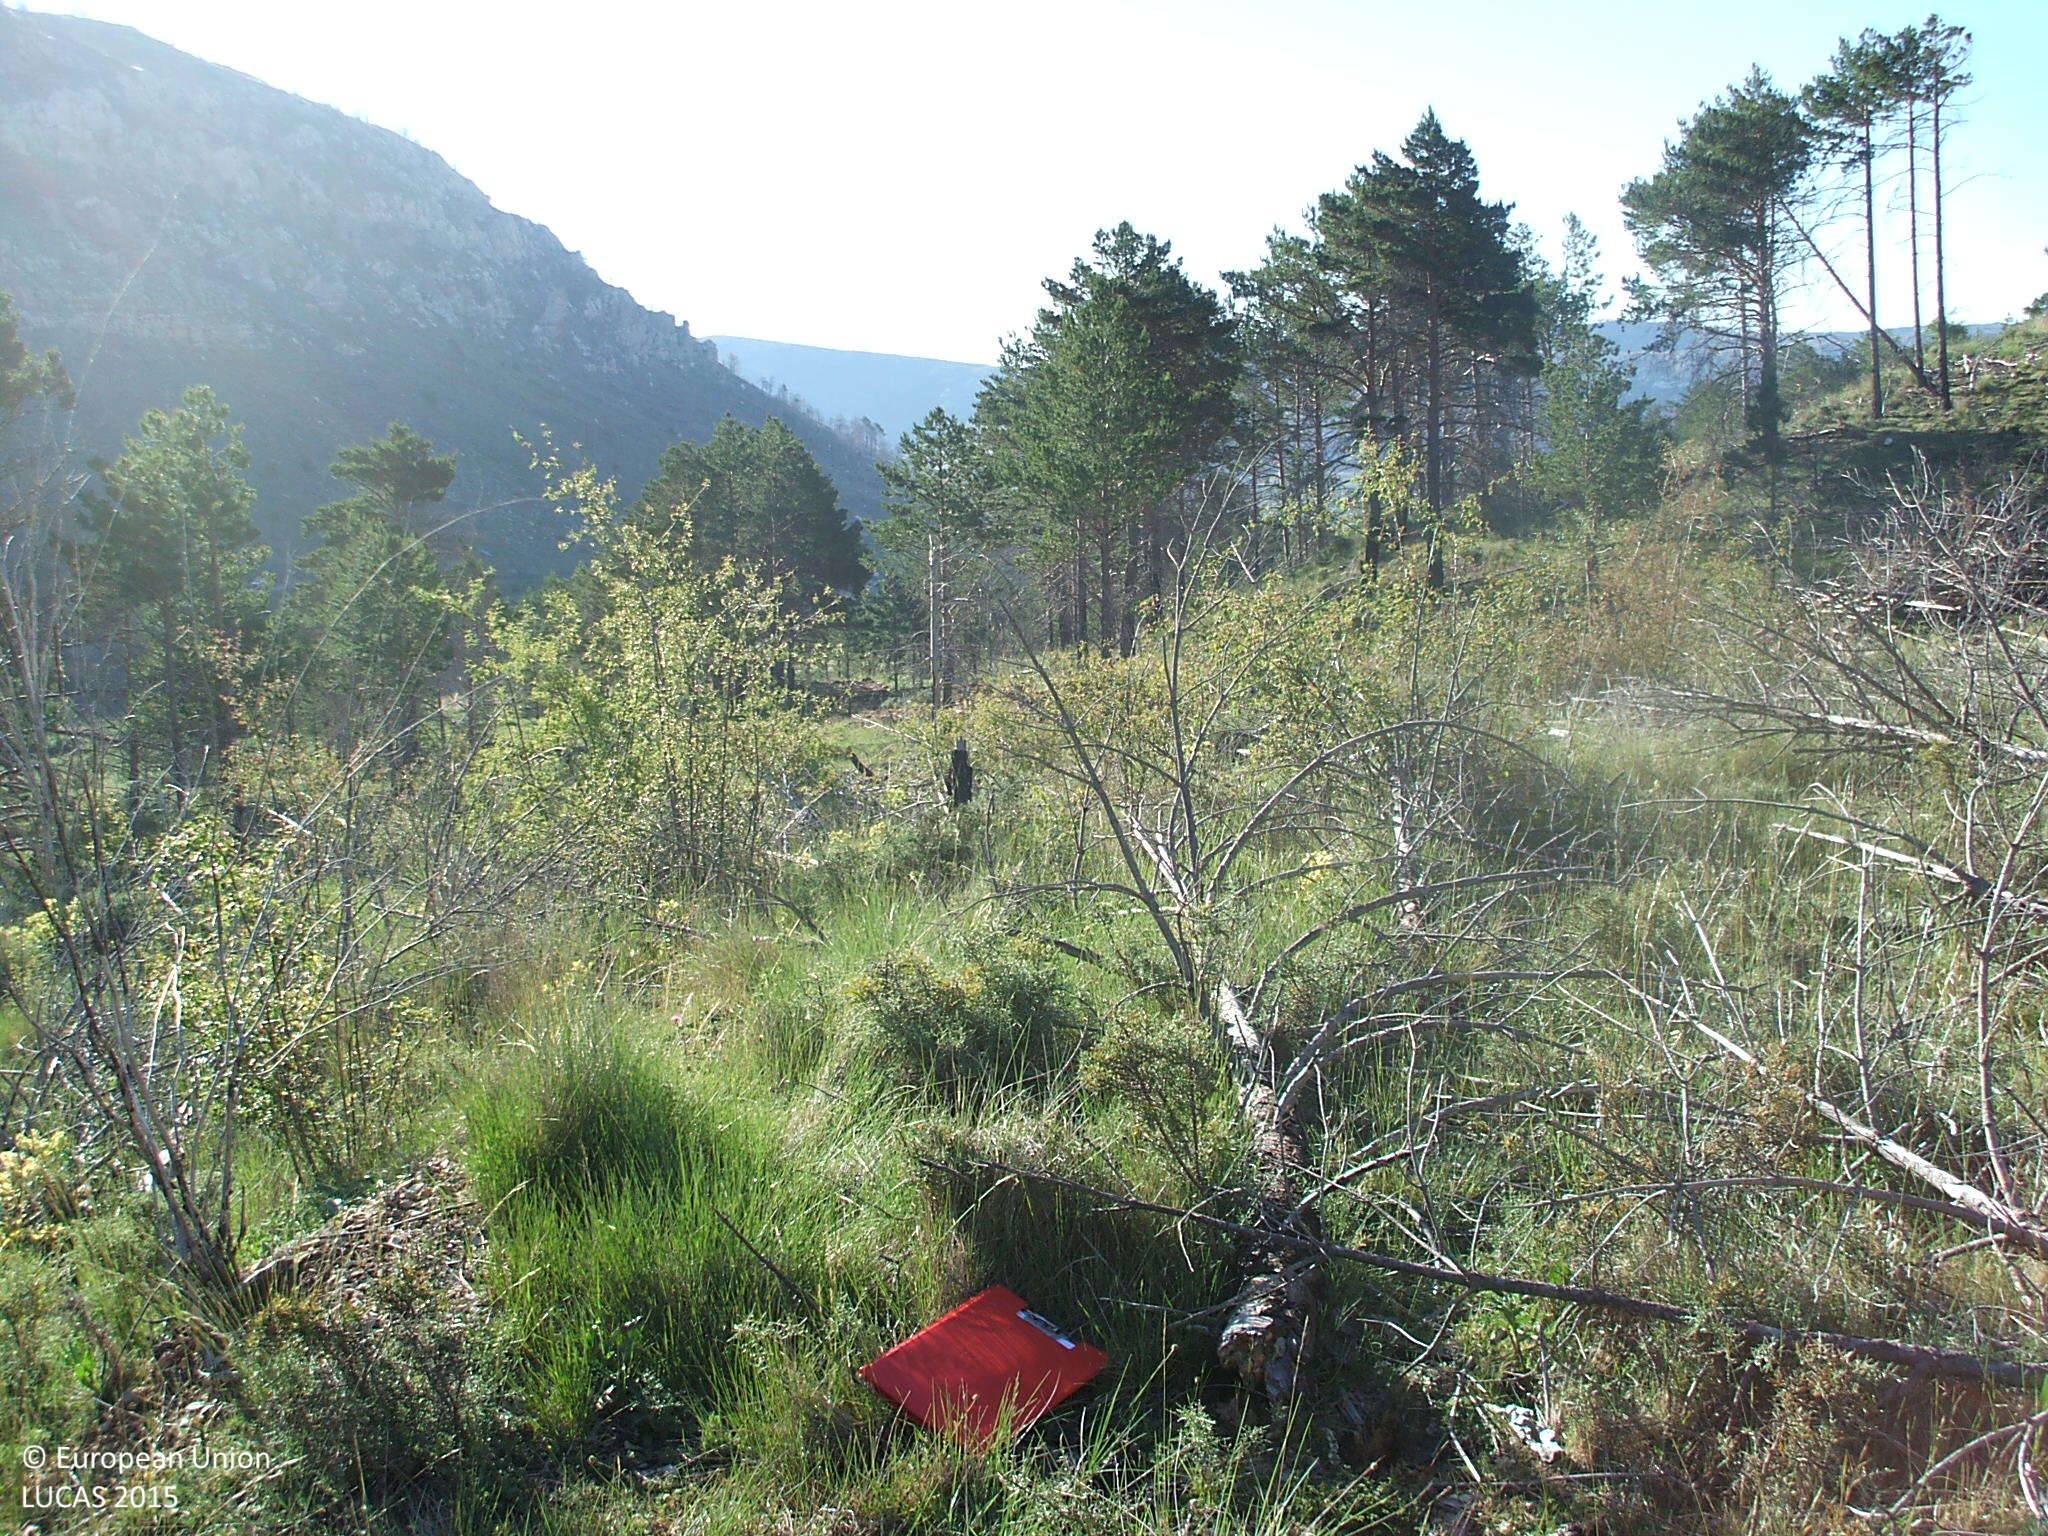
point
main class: Woodland
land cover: Pine dominated coniferous woodland
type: coniferous forest of the mediterranean region
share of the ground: 10 - 25 %
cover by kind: lichens and mosses 85 %, coniferous forest trees 15 %
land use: Semi-natural and natural areas not in use
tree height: > 5 m
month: June
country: ES
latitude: 40.7449
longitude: -0.6347
